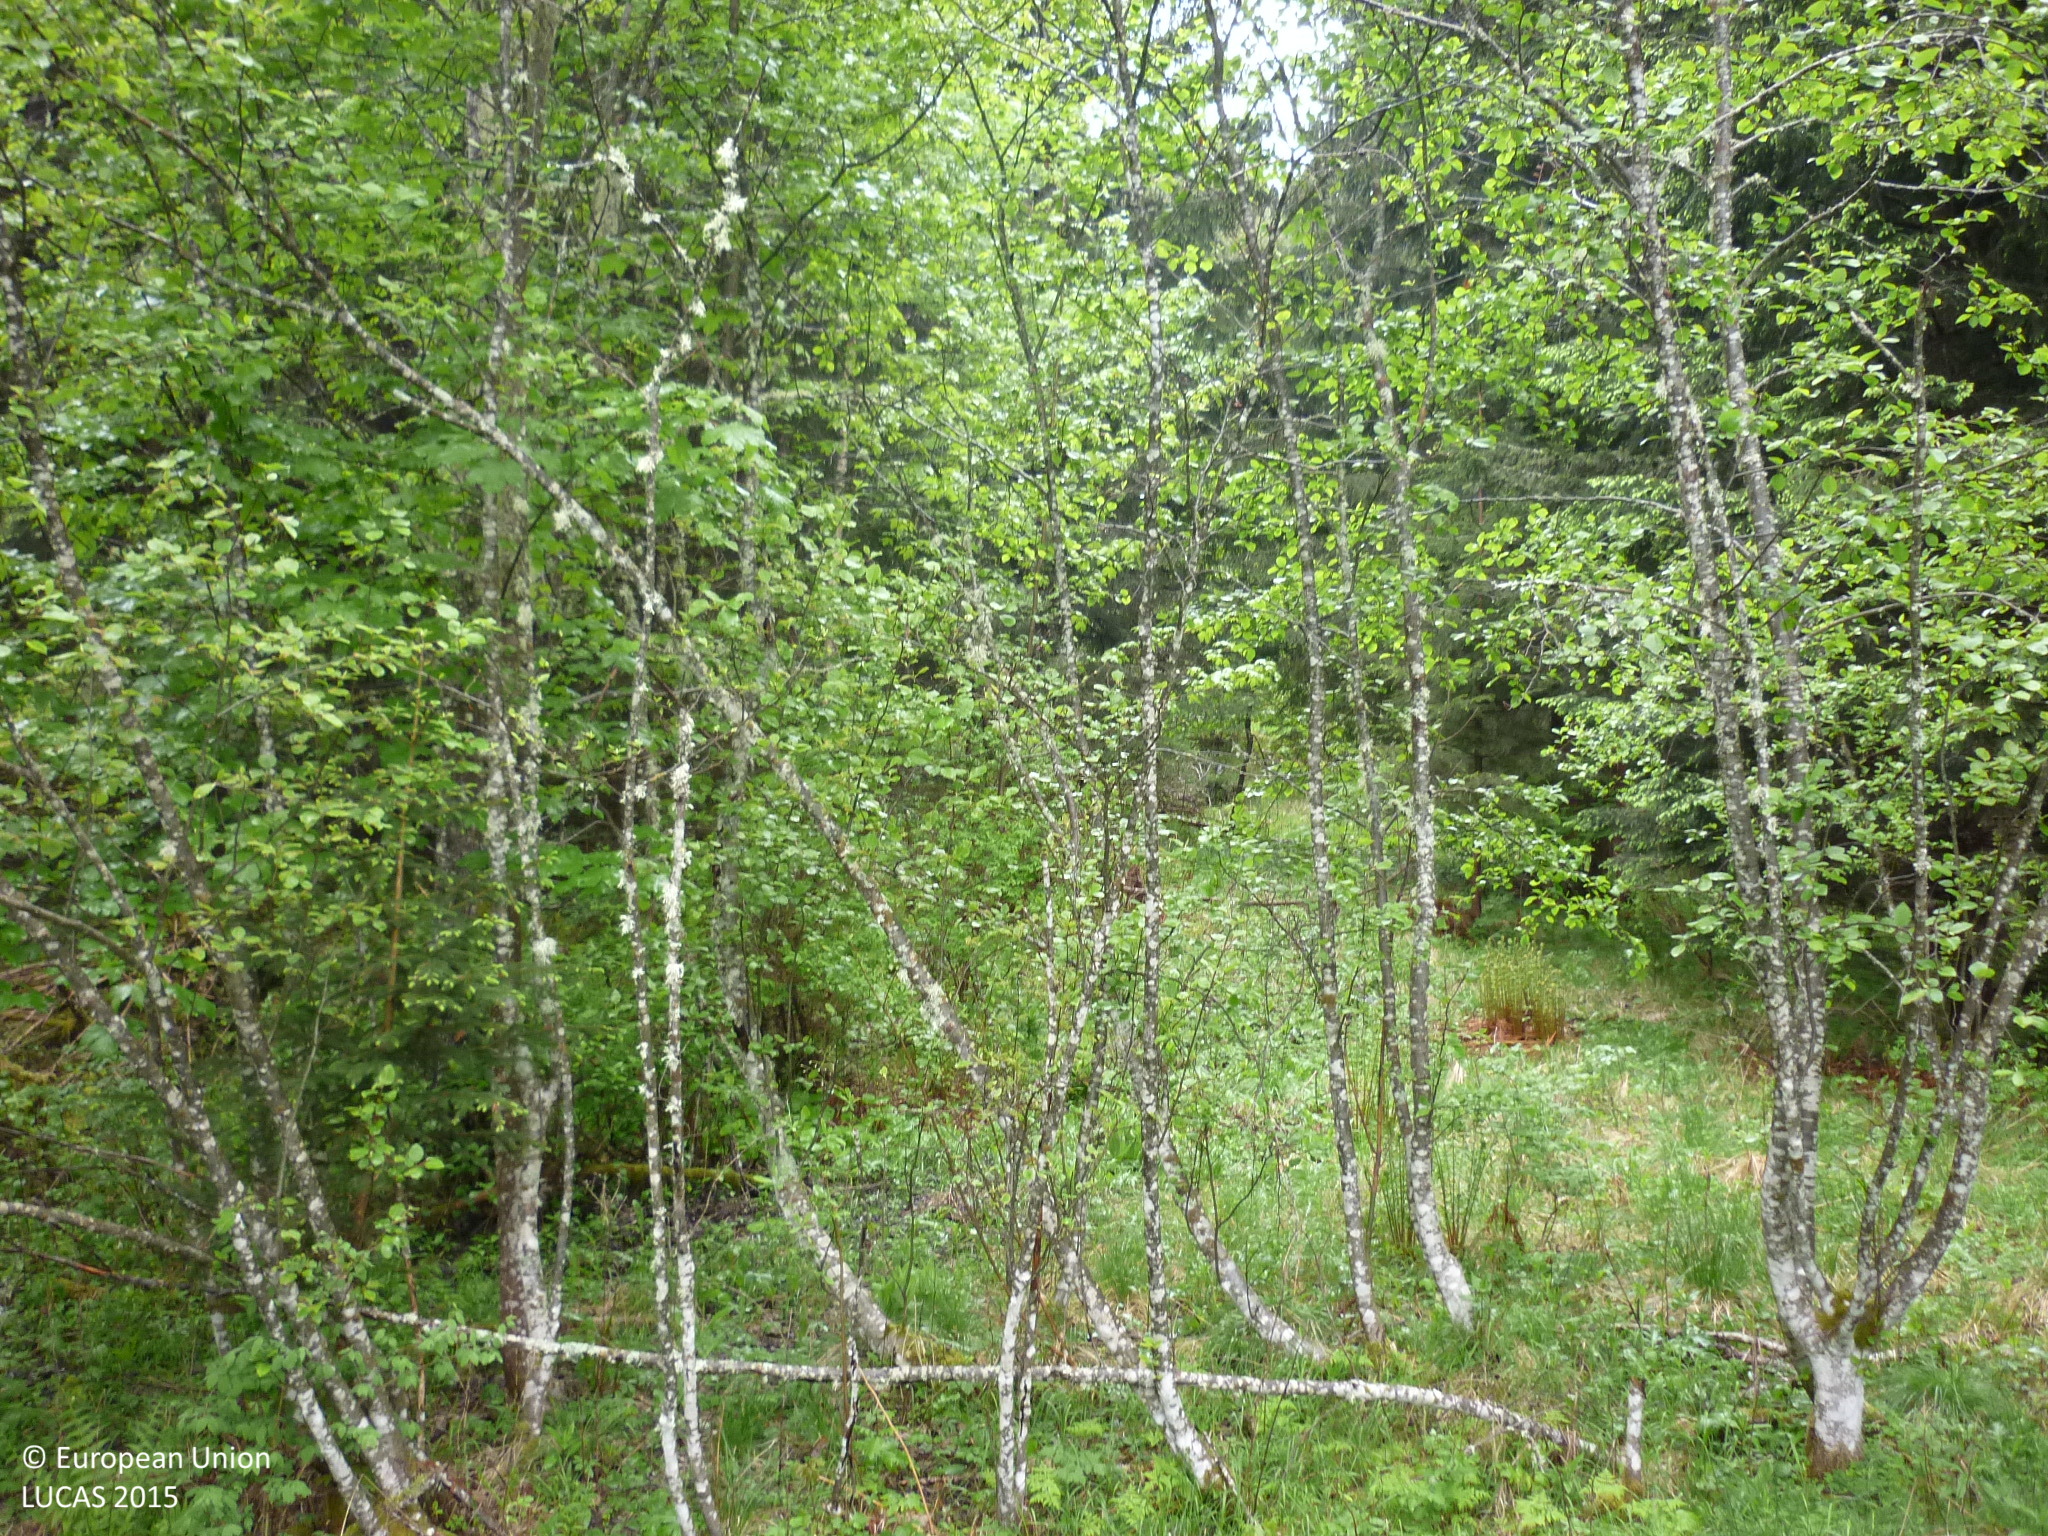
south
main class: Grassland
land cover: Grassland with sparse tree/shrub cover
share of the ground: > 75 %
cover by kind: herbaceous plants 85 %, shrubs 10 %, coniferous forest trees 5 %
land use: Forestry
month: May
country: AT
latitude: 47.1002
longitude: 14.1485
